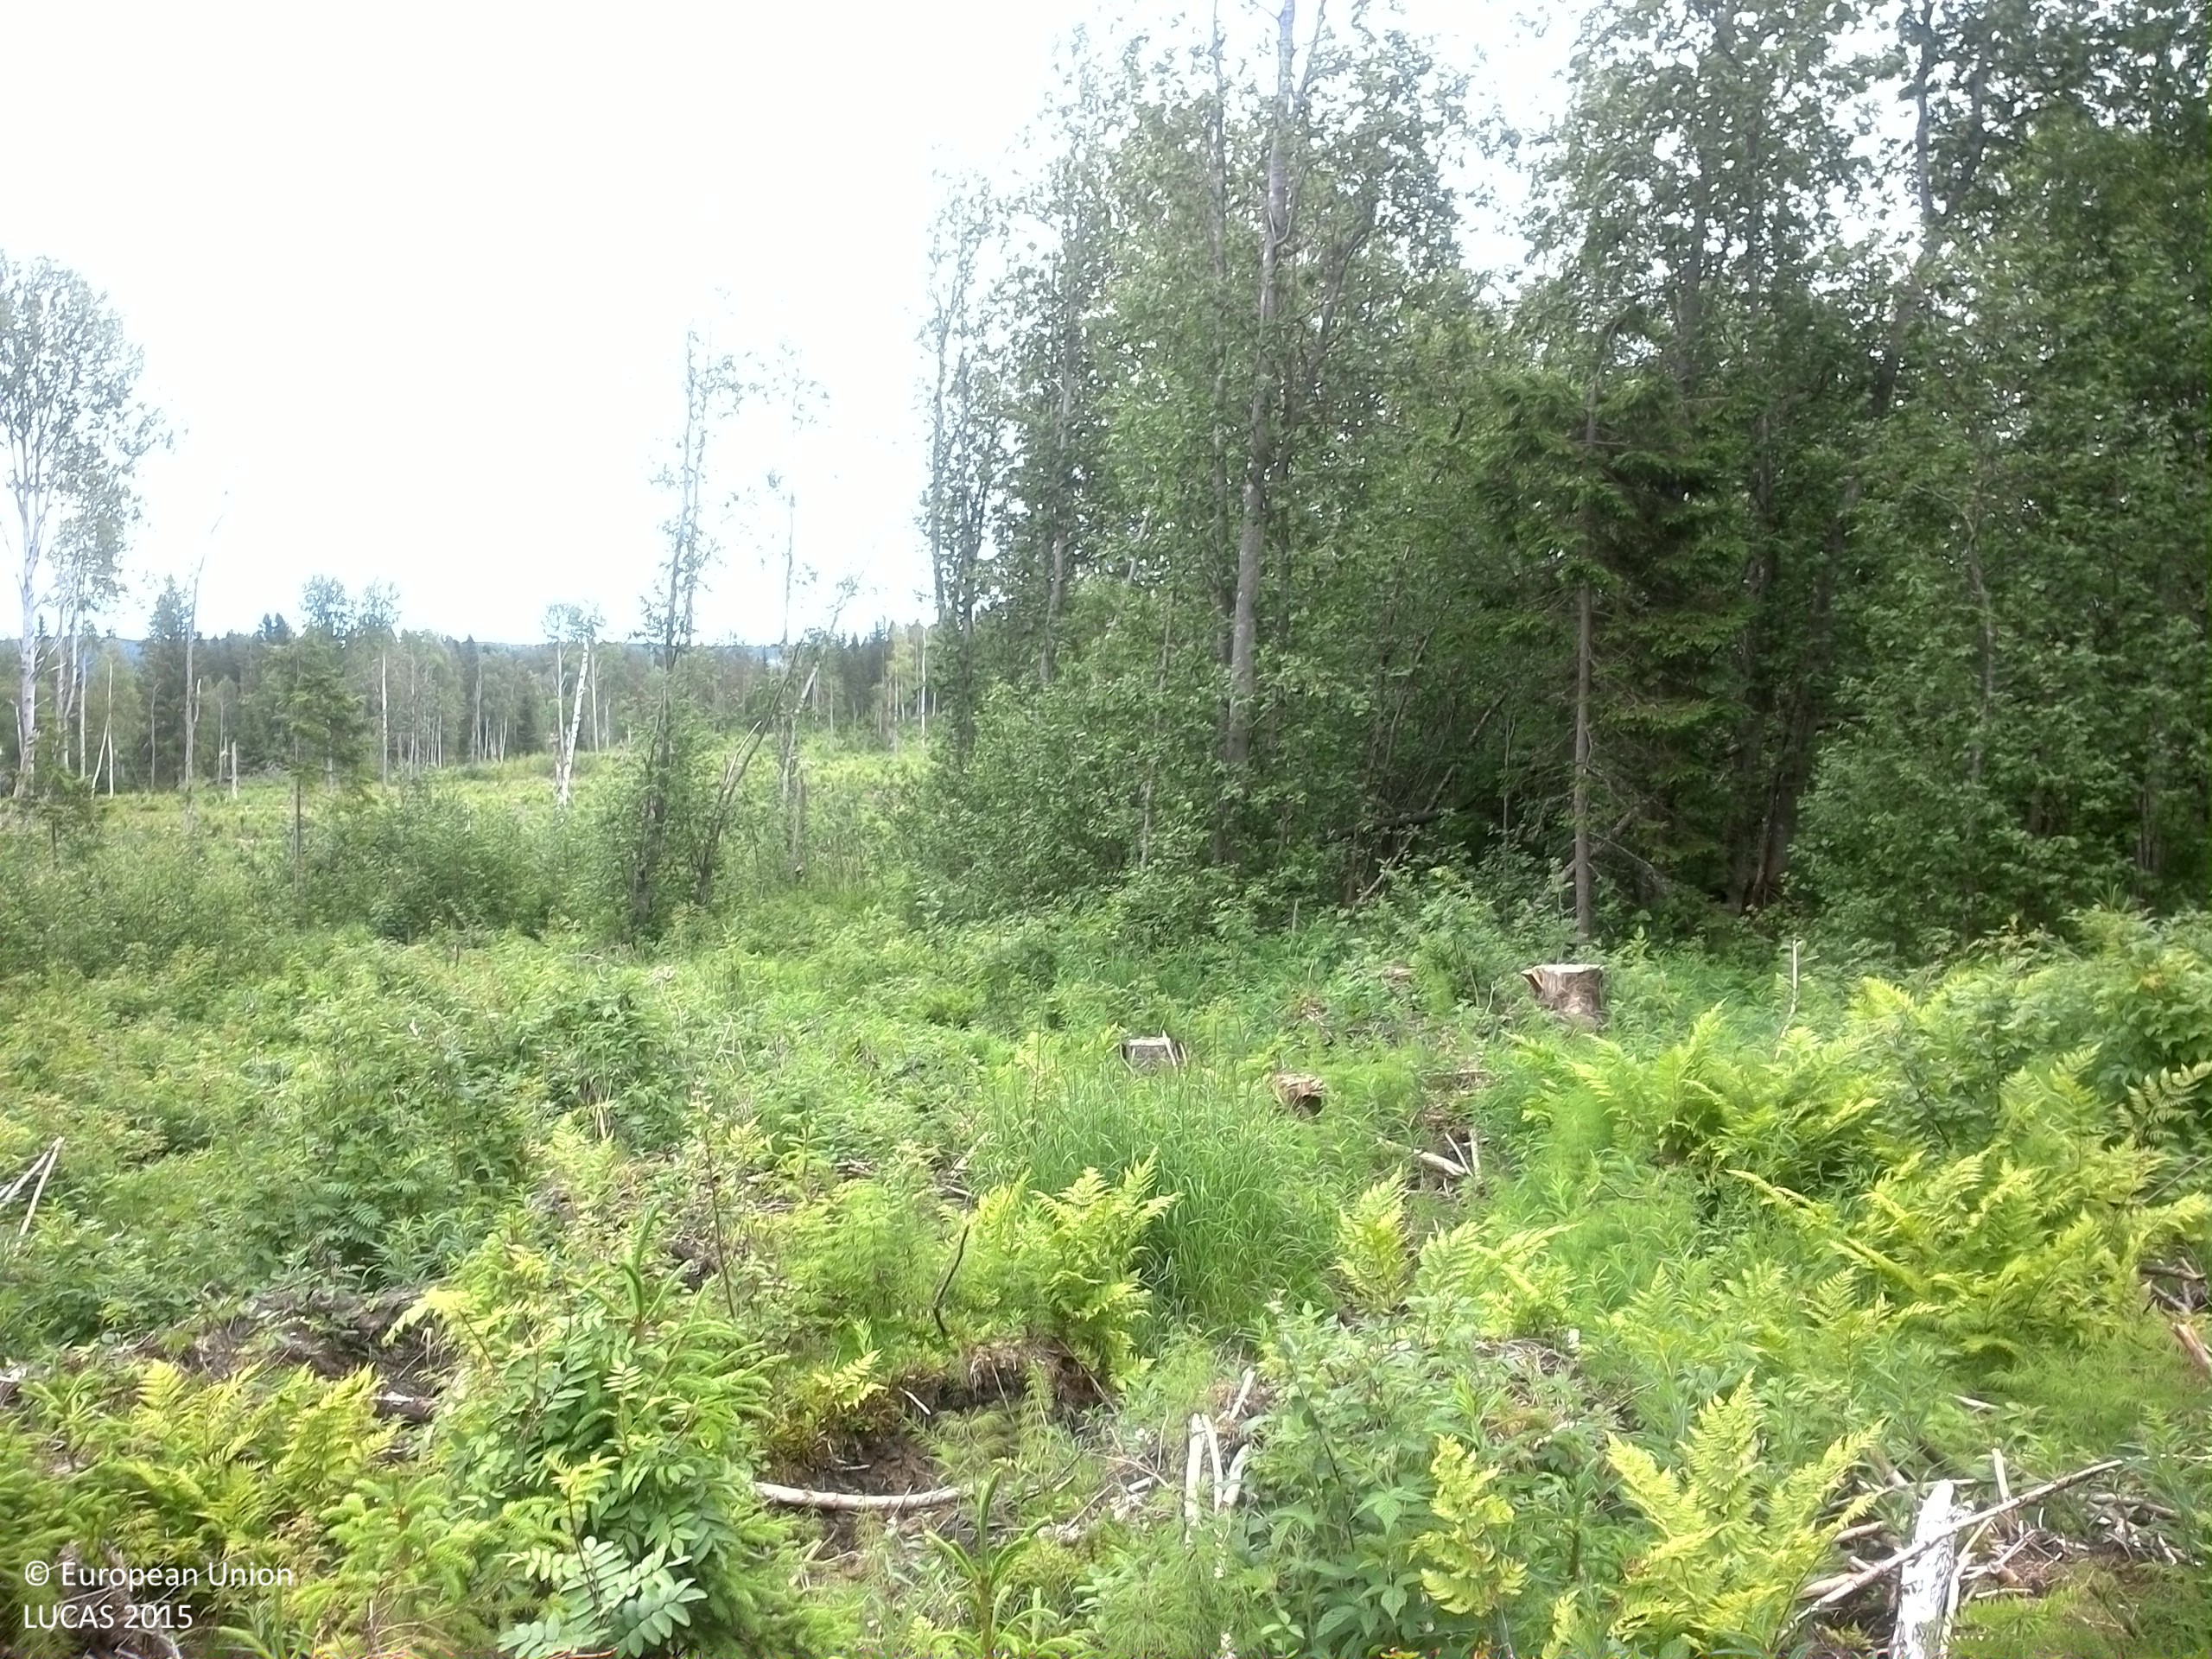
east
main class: Woodland
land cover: Broadleaved woodland
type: boreal forest
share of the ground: 10 - 25 %
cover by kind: shrubs 40 %, broadleaved forest trees 25 %, herbaceous plants 25 %, unconsolidated bare surface 10 %
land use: Forestry
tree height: < 5 m
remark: Clear cut
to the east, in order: Broadleaved woodland; Ditches and canals; Broadleaved woodland; Ditches and canals; Broadleaved woodland; Ditches and canals; Broadleaved woodland
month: July
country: SE
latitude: 62.6555
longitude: 17.6095
